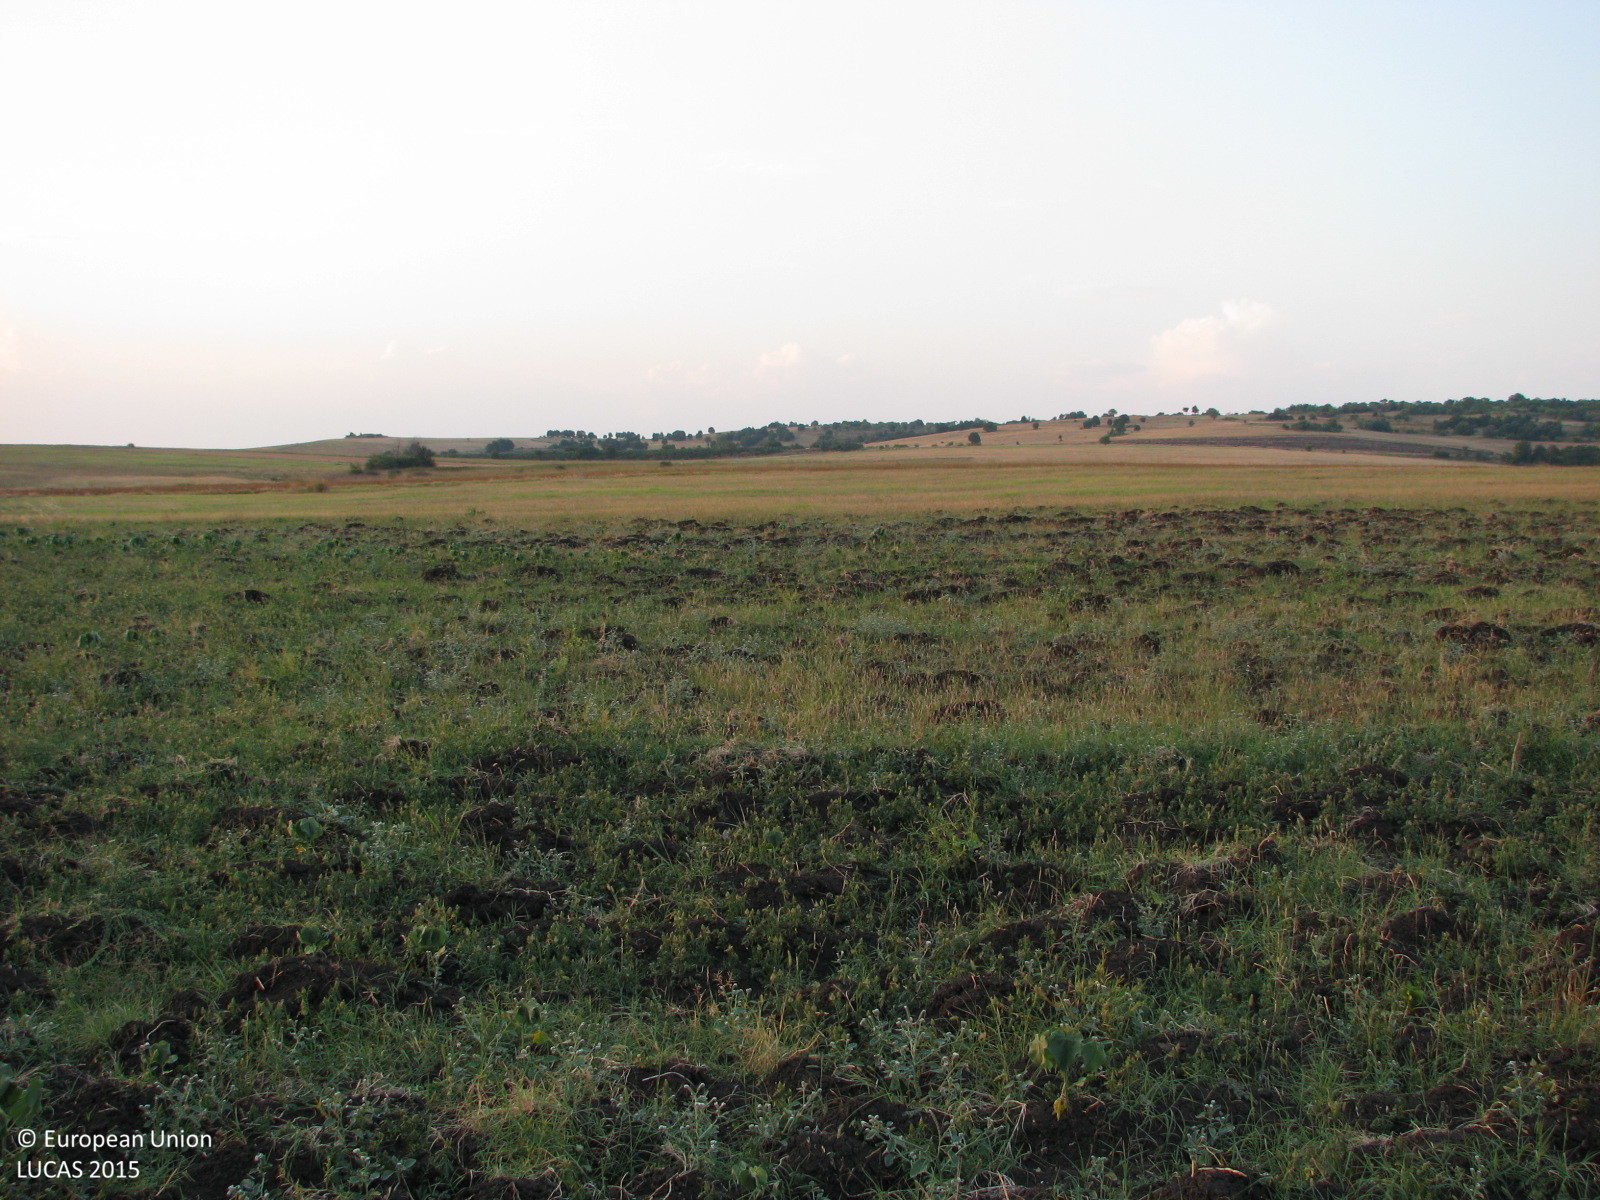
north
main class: Grassland
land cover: Spontaneously vegetated surfaces
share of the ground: > 75 %
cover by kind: herbaceous plants 90 %, unconsolidated bare surface 10 %
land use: Agriculture (excluding fallow land and kitchen gardens)
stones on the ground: < 10 %
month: August
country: BG
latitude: 42.1899
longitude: 26.3965
